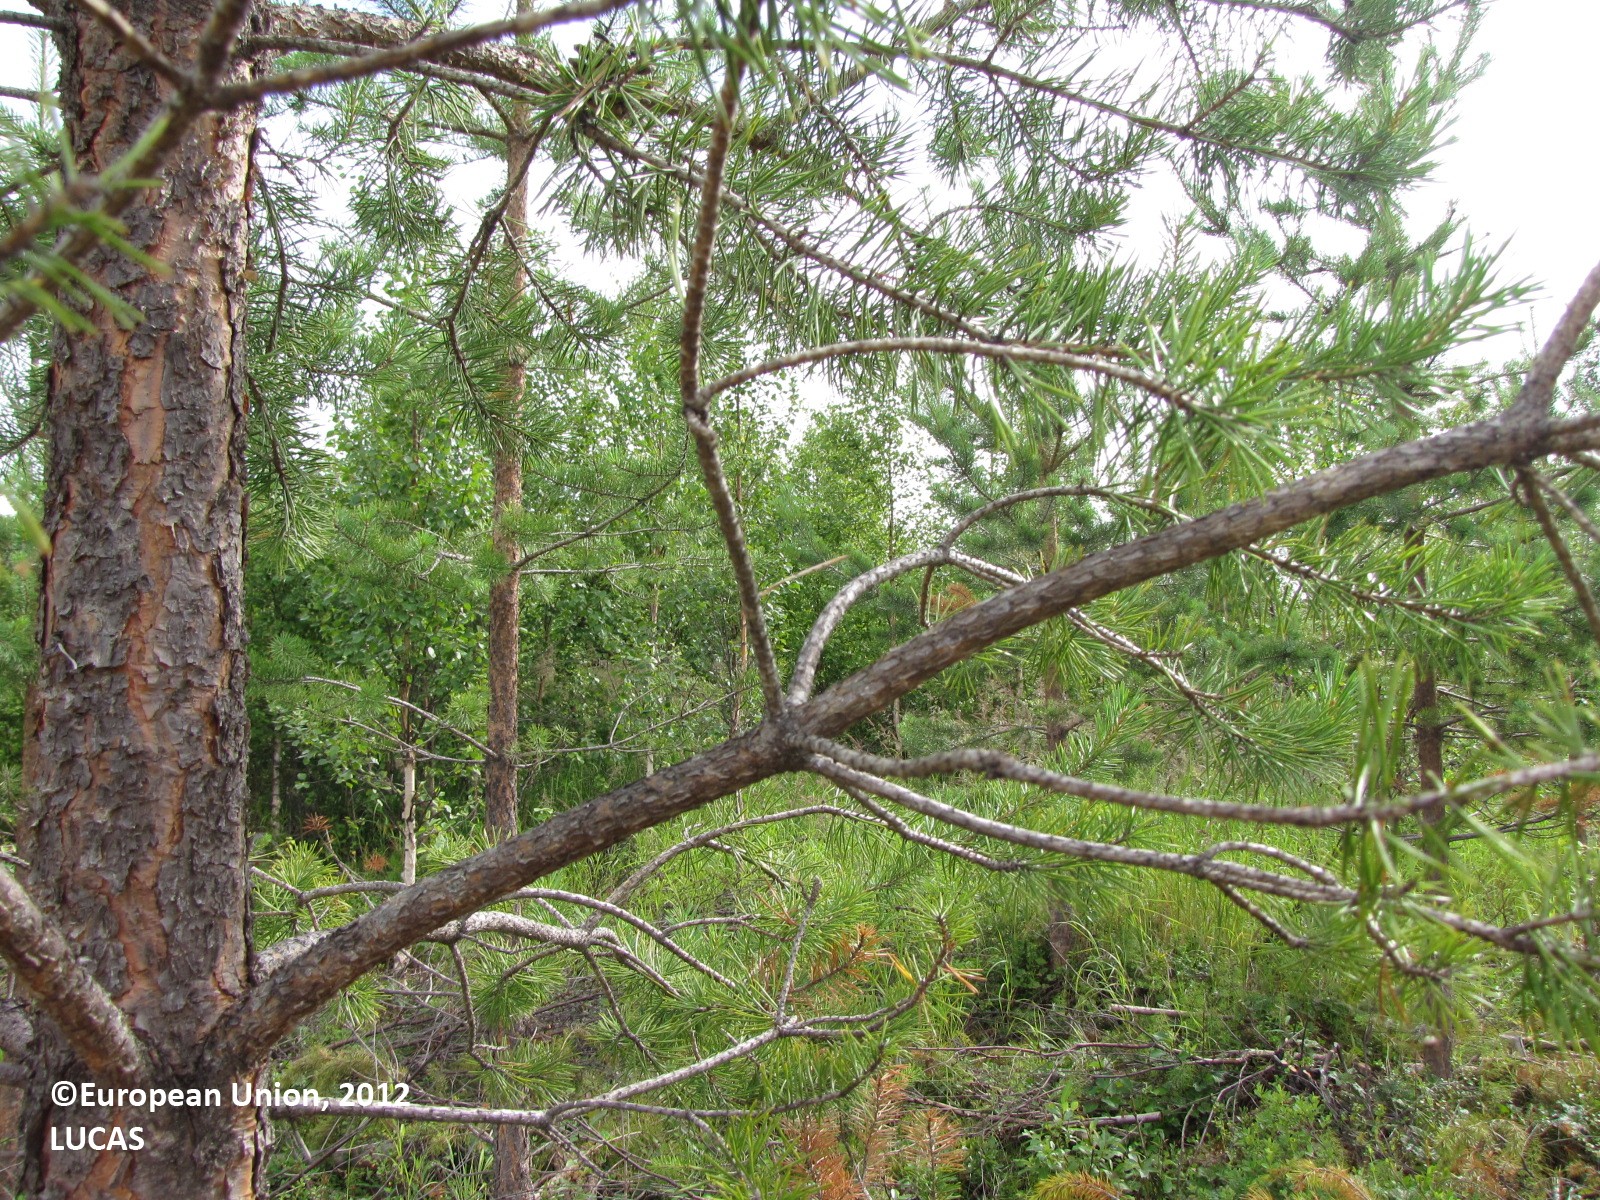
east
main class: Woodland
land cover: Pine dominated mixed woodland
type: boreal forest
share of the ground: 25 - 50 %
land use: Forestry
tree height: > 5 m
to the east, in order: Pine dominated mixed woodland; Broadleaved woodland; Spruce dominated coniferous woodland
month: August
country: FI
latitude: 66.7328
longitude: 24.5385
